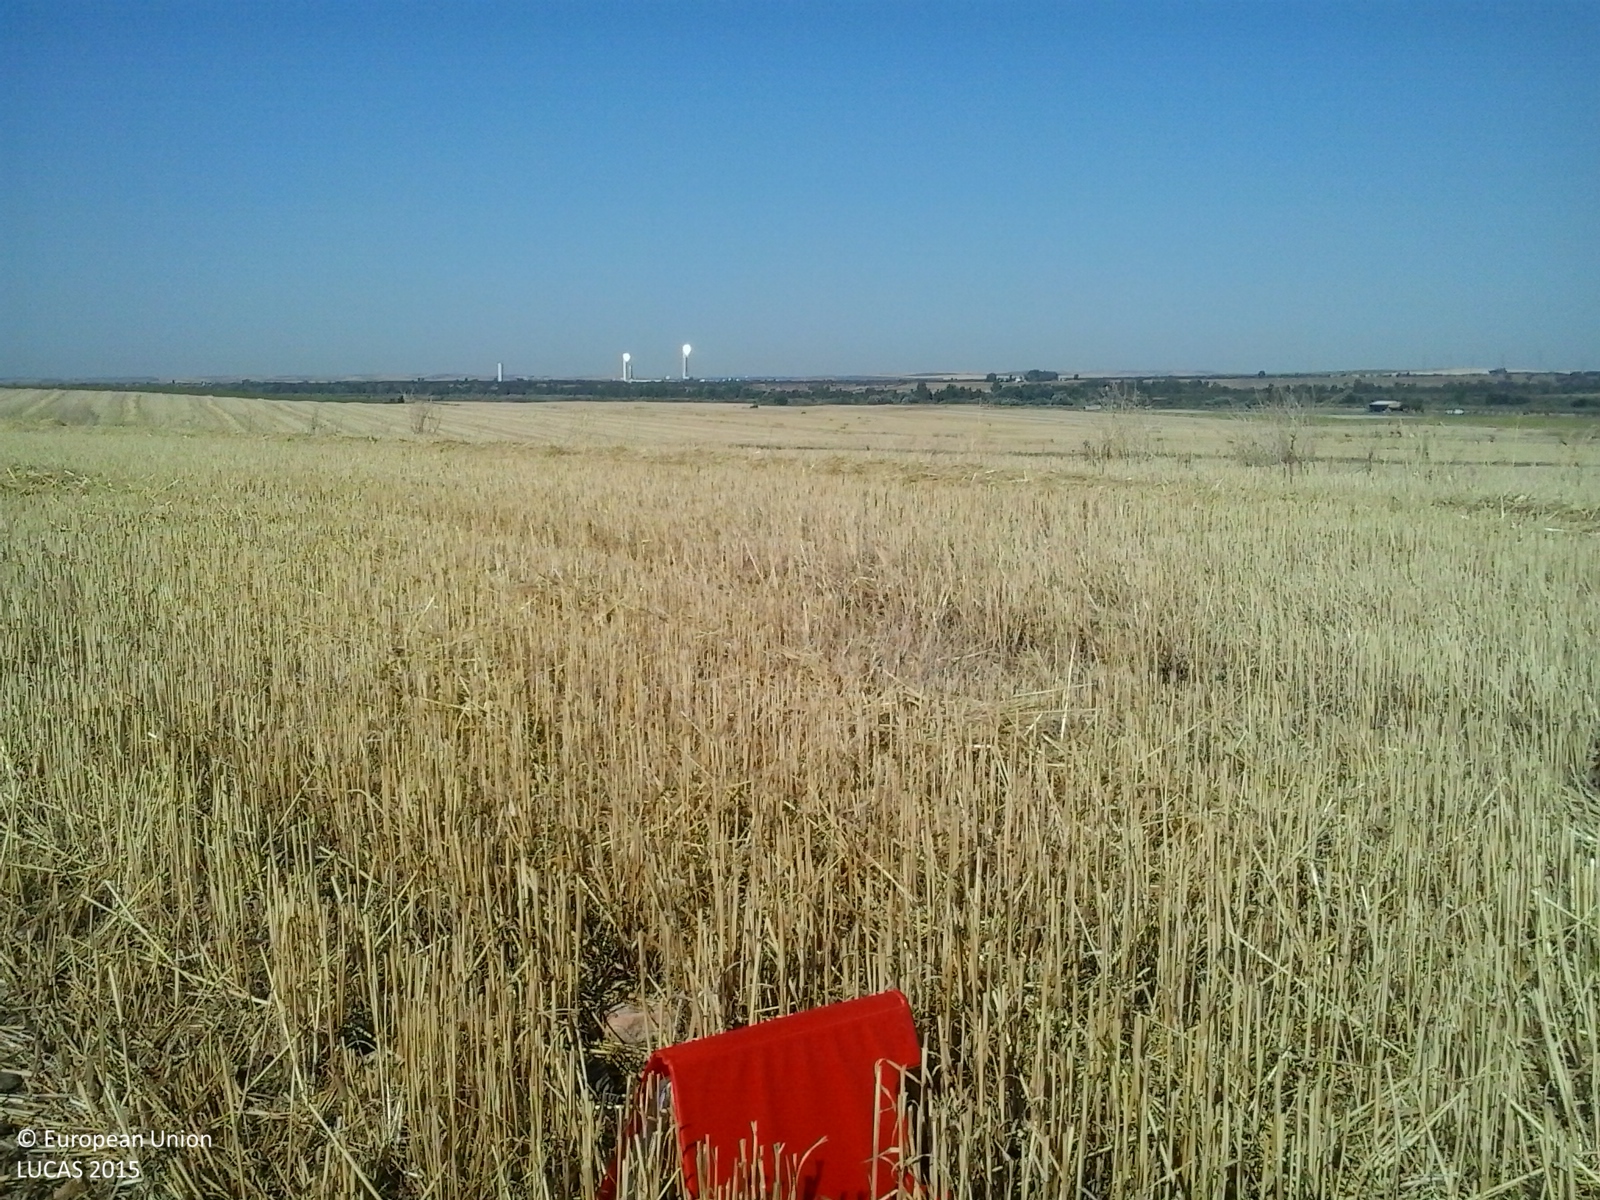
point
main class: Cropland
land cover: Common wheat
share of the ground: < 10 %
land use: Agriculture (excluding fallow land and kitchen gardens)
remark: Harvested field
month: June
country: ES
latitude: 37.4758
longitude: -6.1876
